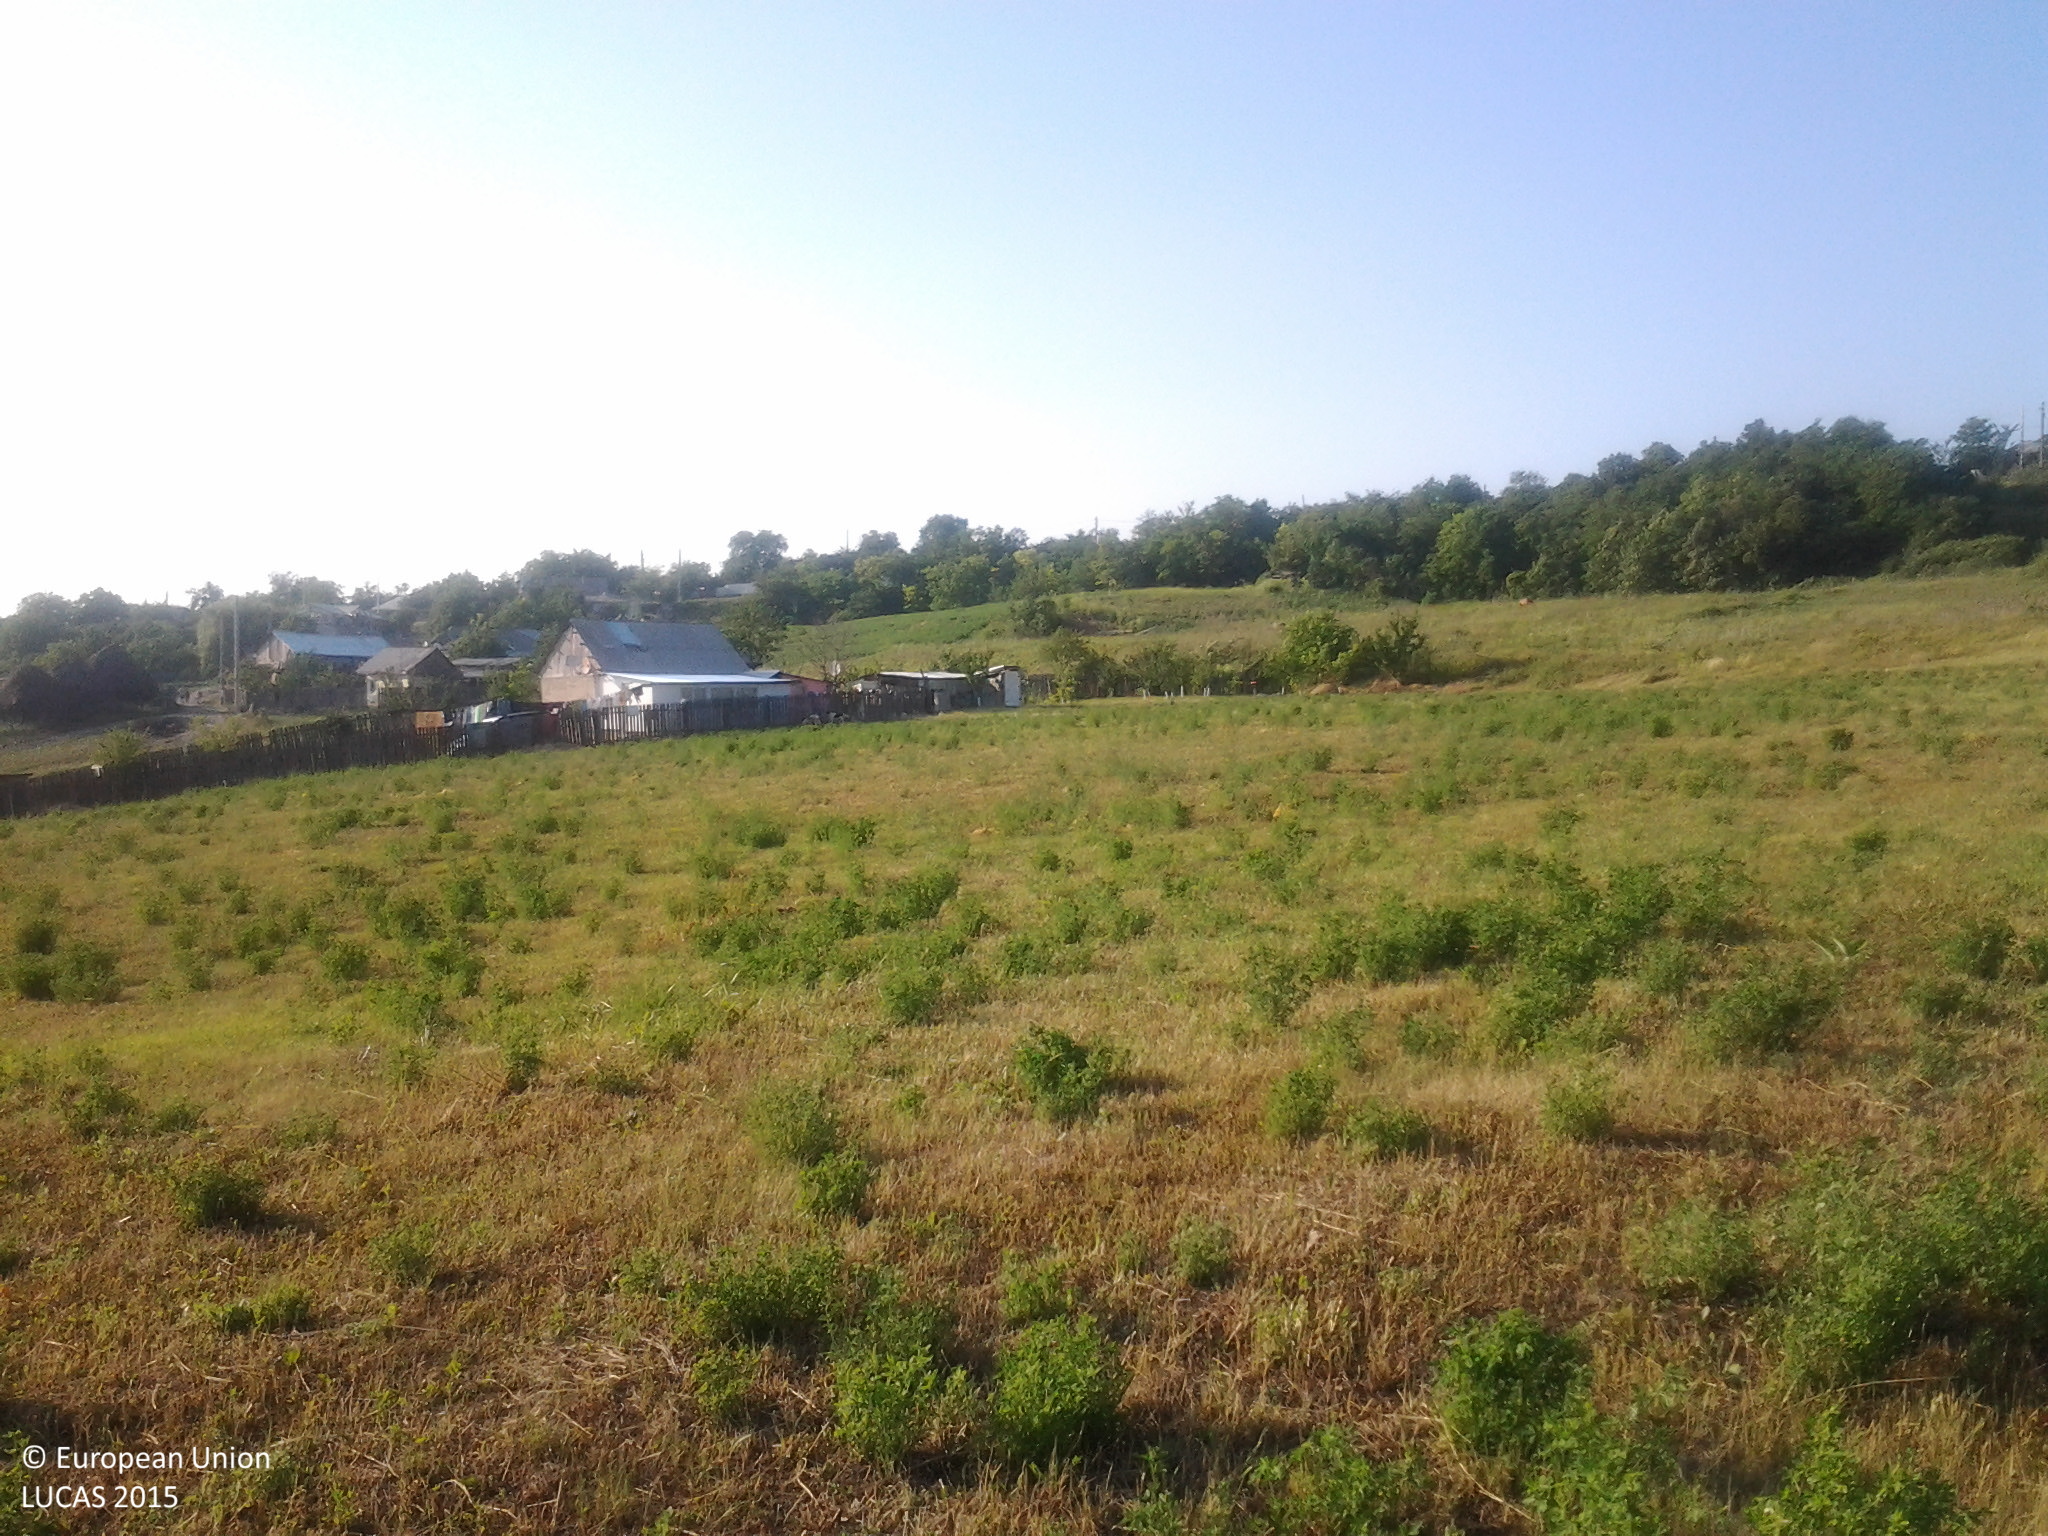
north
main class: Cropland
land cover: Other leguminous and mixtures for fodder
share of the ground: > 75 %
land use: Agriculture (excluding fallow land and kitchen gardens)
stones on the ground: < 10 %
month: June
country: RO
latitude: 46.6317
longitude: 27.1199
